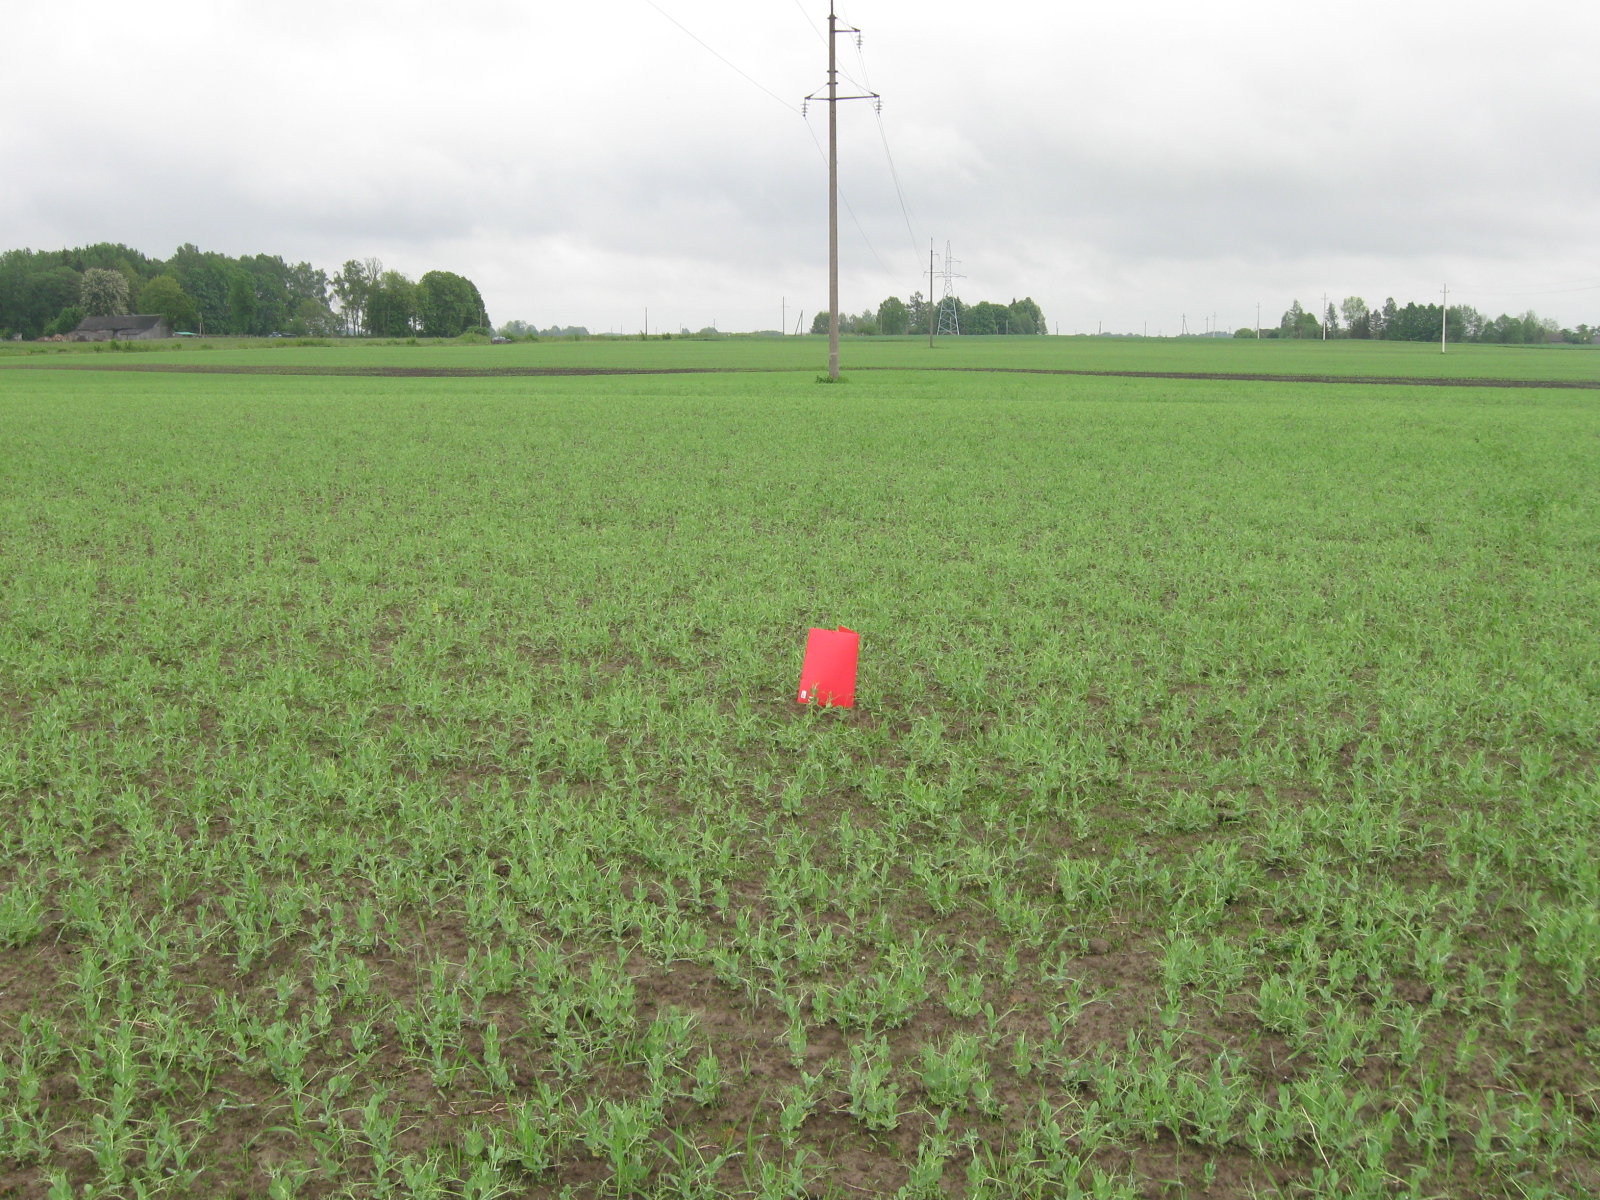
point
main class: Cropland
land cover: Dry pulses
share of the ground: > 75 %
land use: Agriculture (excluding fallow land and kitchen gardens)
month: May
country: LT
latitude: 54.9636
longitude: 22.7653
